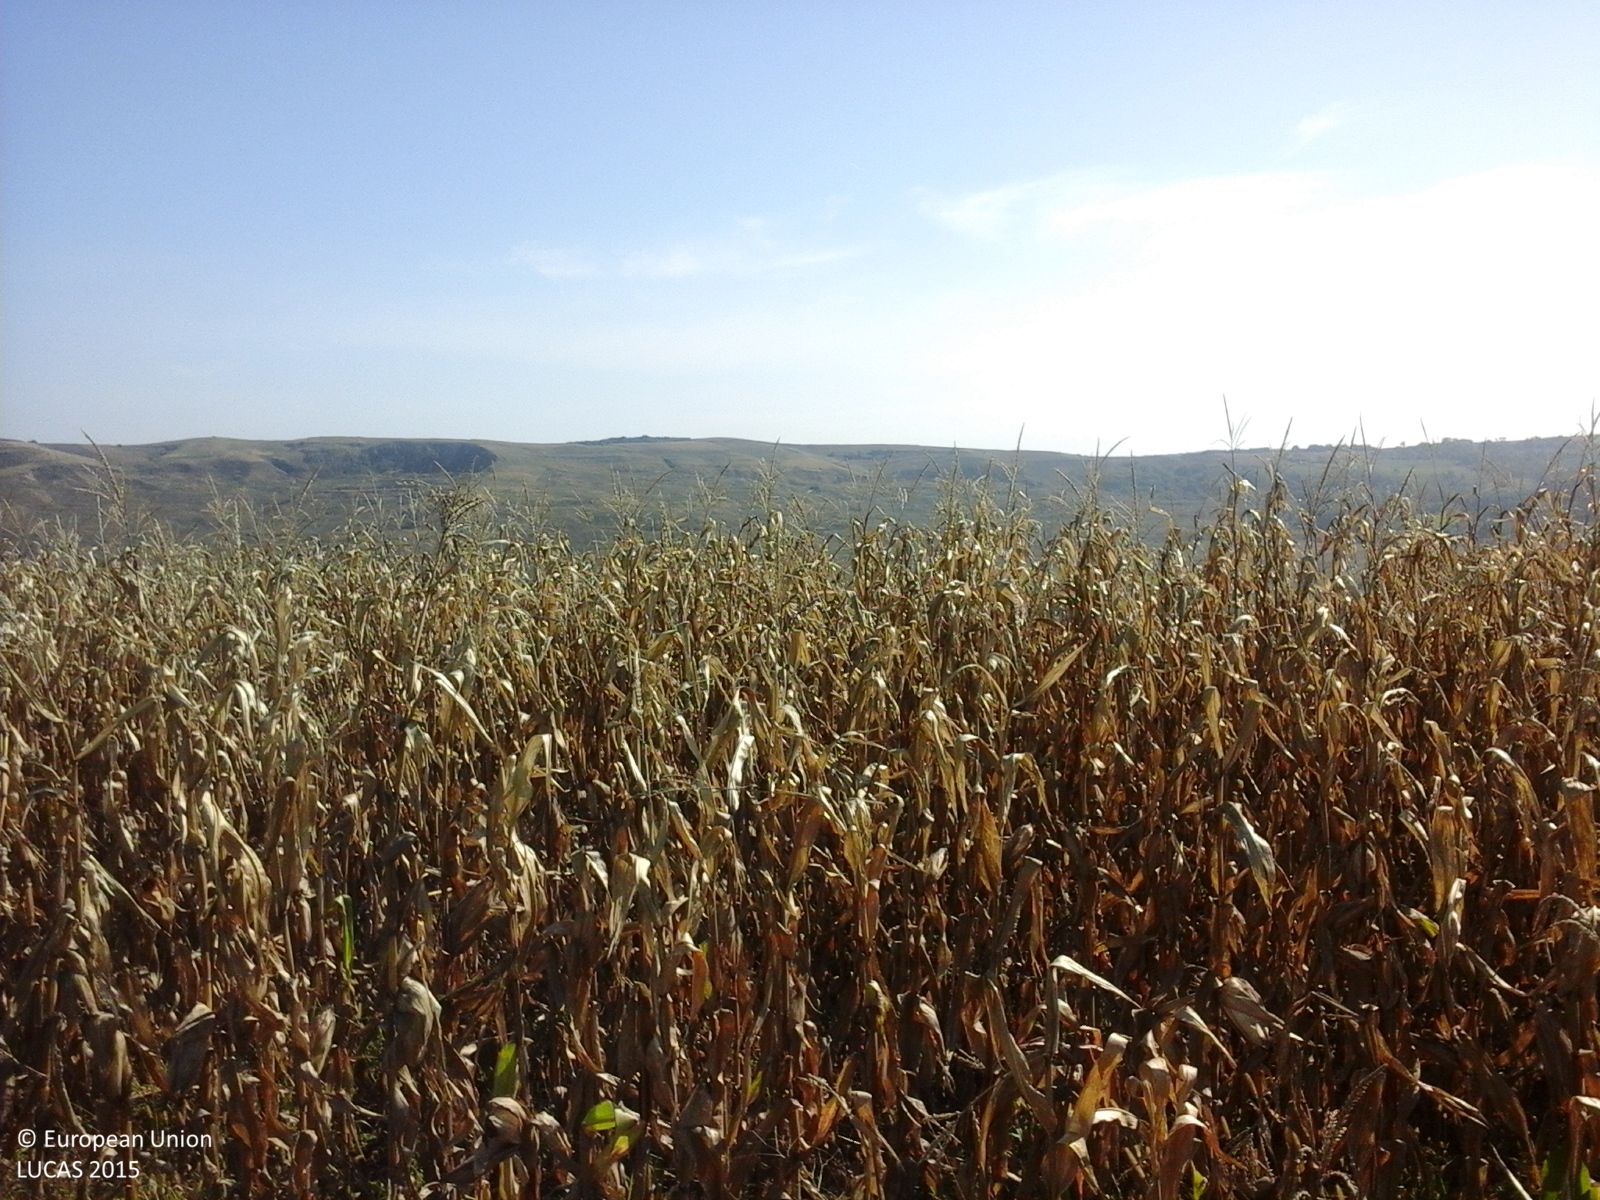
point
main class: Cropland
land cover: Maize
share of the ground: > 75 %
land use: Agriculture (excluding fallow land and kitchen gardens)
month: October
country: RO
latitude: 46.1203
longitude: 23.8532
